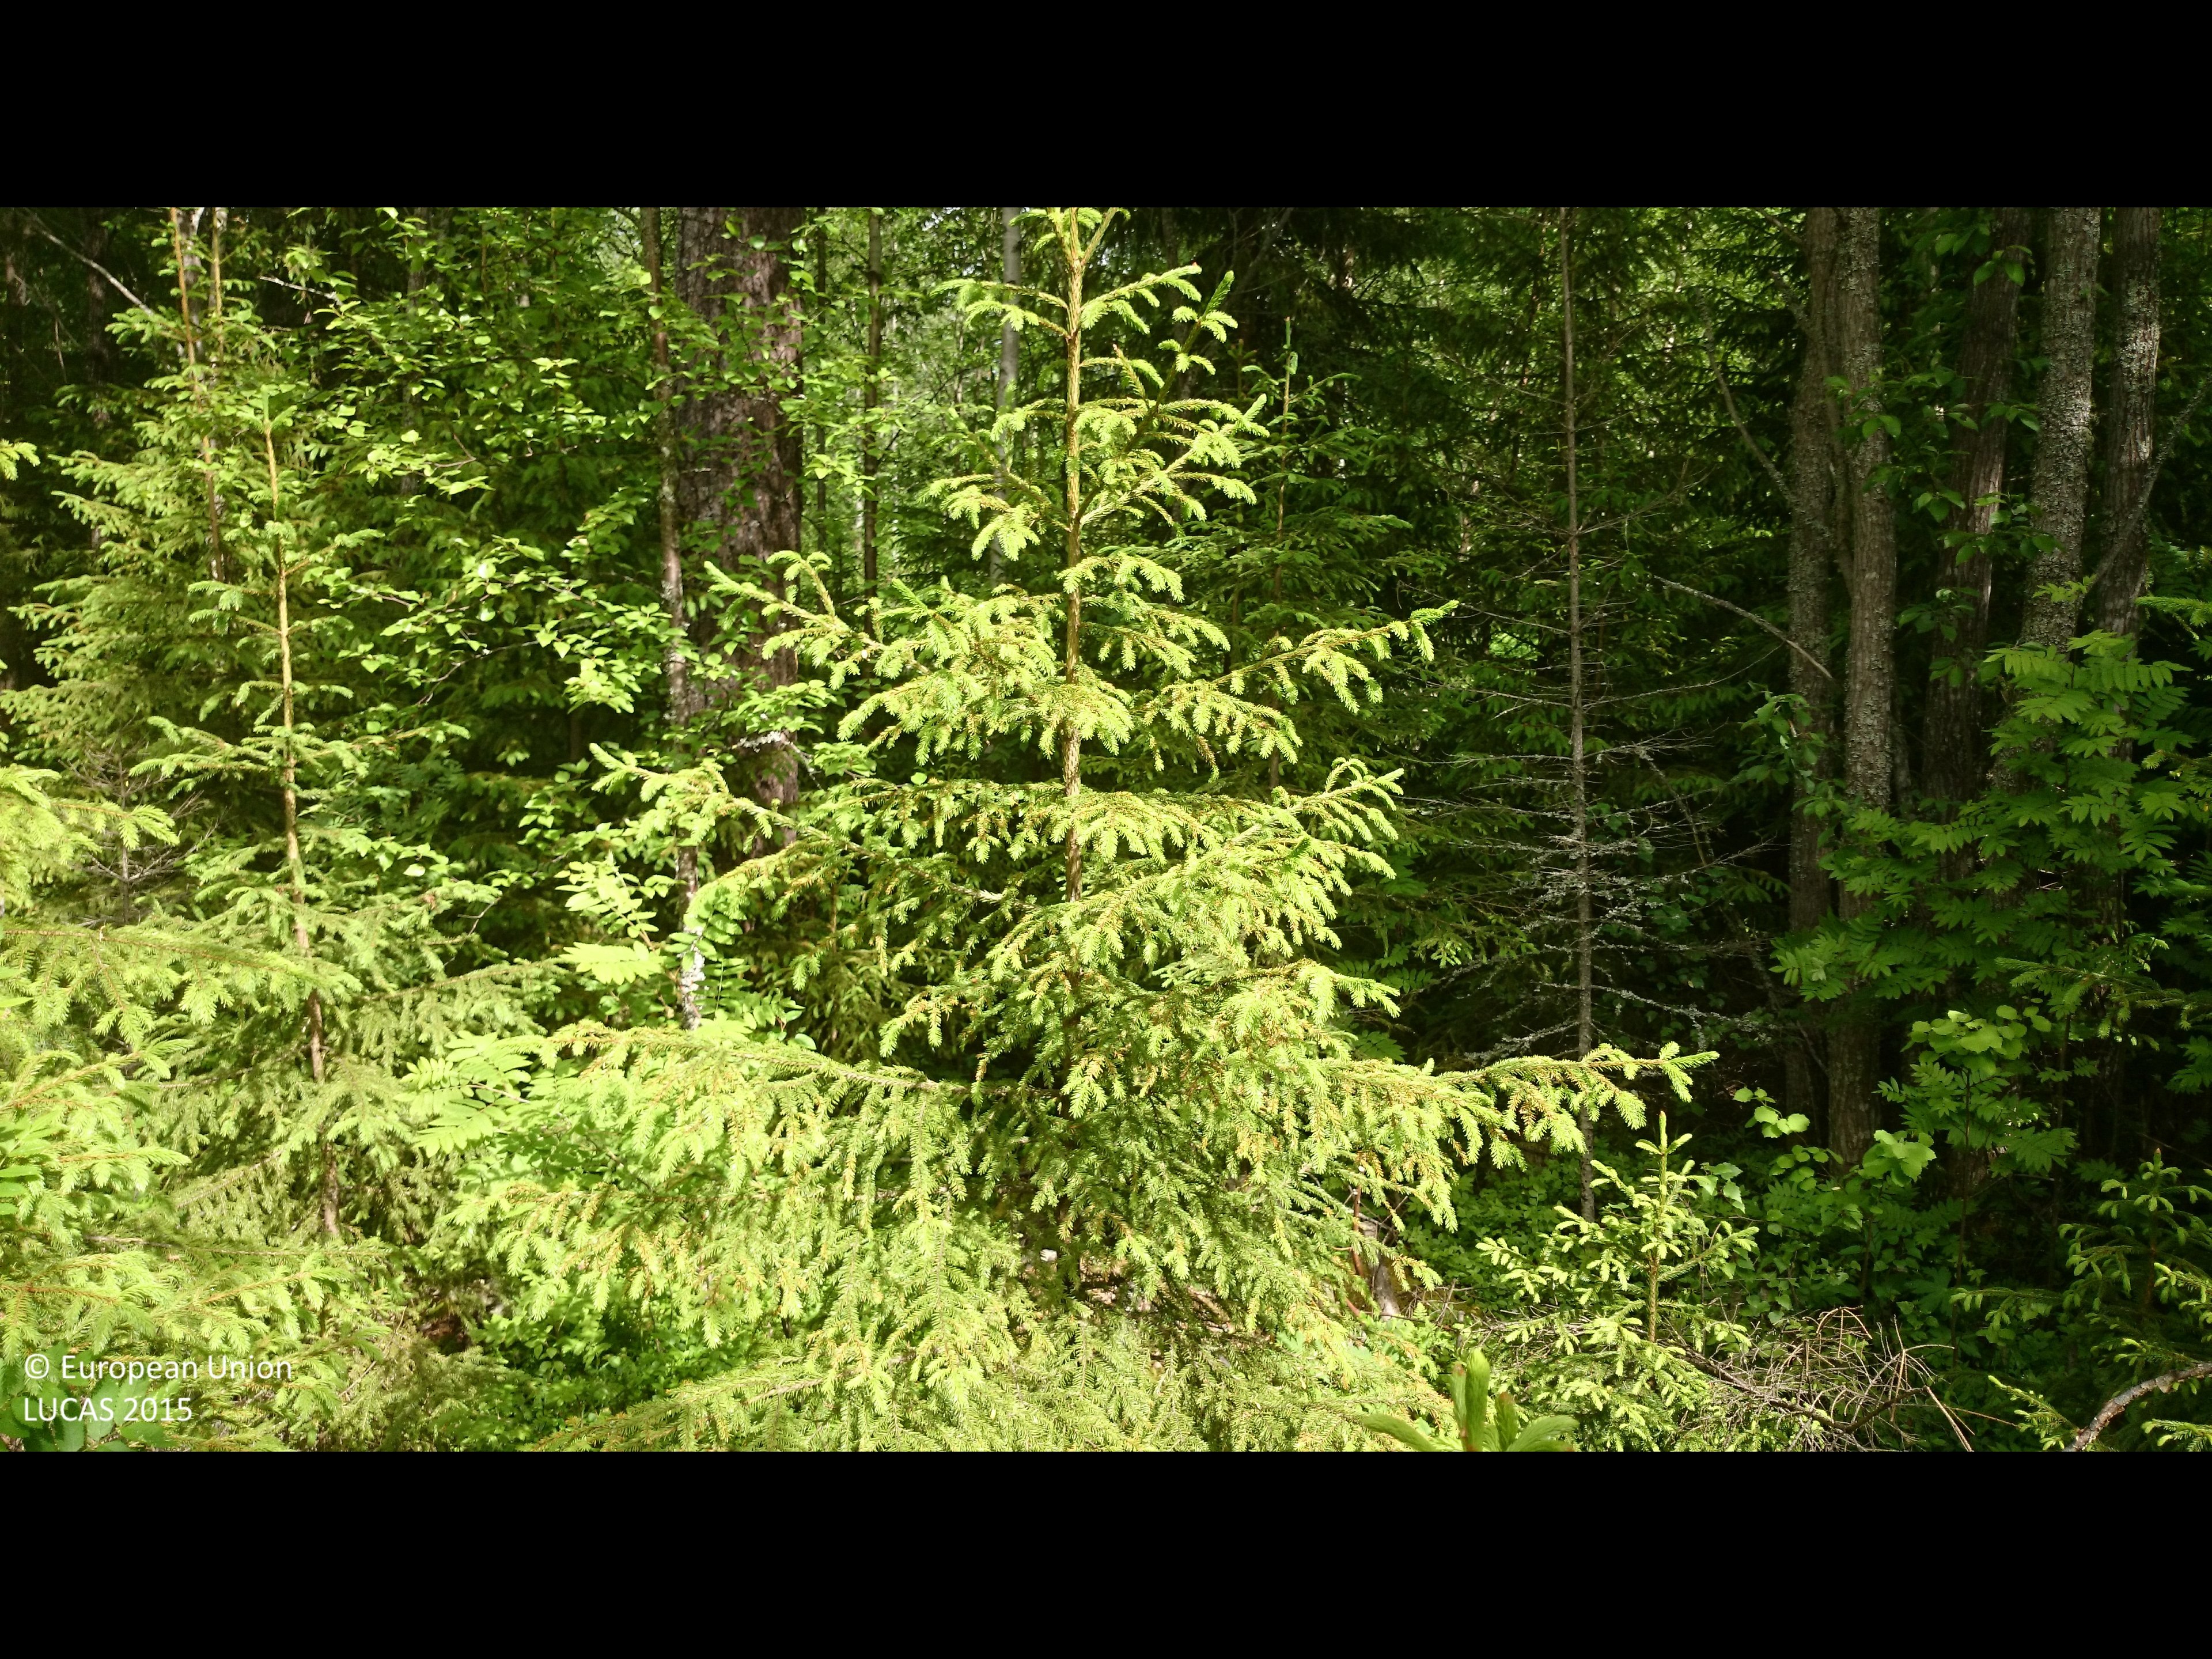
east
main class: Woodland
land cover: Other mixed woodland
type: boreal forest
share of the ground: 50 - 75 %
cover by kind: broadleaved forest trees 35 %, coniferous forest trees 30 %, herbaceous plants 20 %, lichens and mosses 15 %
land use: Forestry
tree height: > 5 m
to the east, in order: Other mixed woodland; Ditches and canals; Paved roads, cycling and walking lanes; Ditches and canals; Spruce dominated mixed woodland; Grassland with sparse tree/shrub cover; Broadleaved woodland; Inland marshes; Inland fresh water bodies
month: June
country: SE
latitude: 62.0813
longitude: 16.7396
